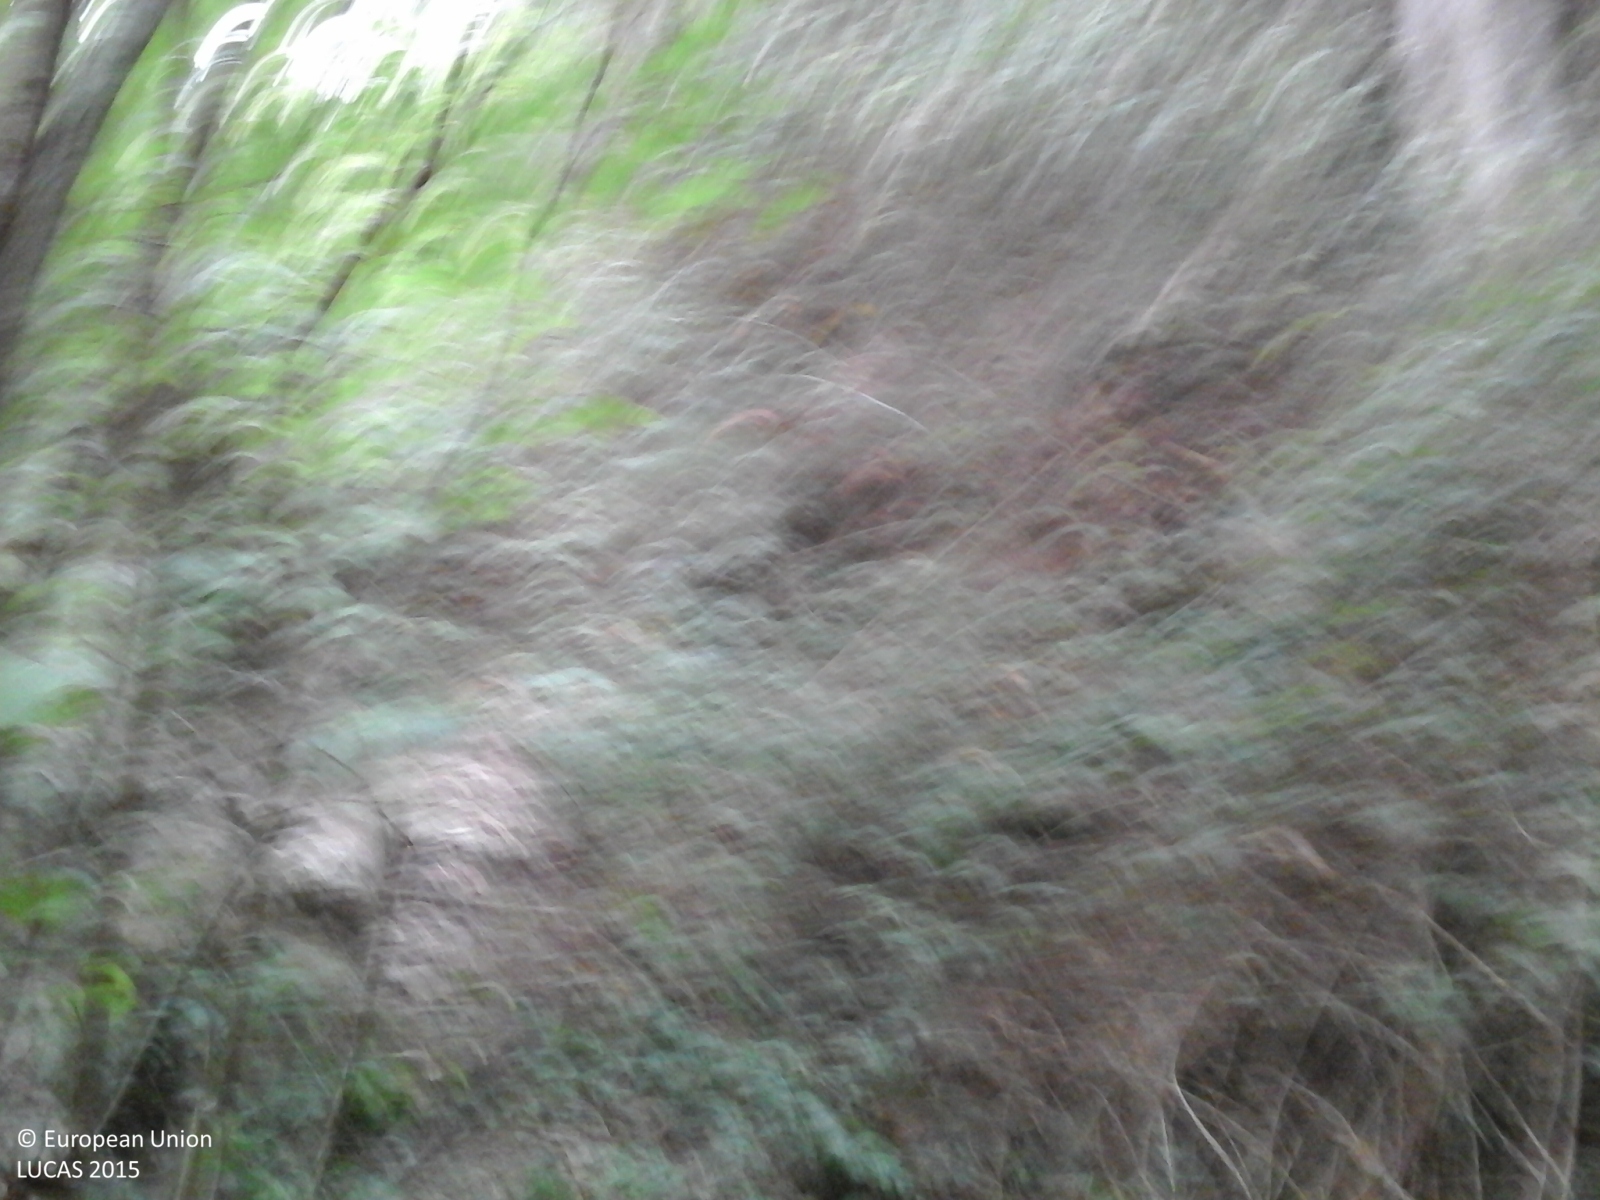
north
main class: Woodland
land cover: Broadleaved woodland
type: thermophilous deciduous forest
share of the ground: > 75 %
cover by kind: broadleaved forest trees 100 %
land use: Forestry
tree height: > 5 m
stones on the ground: 25 - 50 %
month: September
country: IT
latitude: 44.3666
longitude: 9.3615
